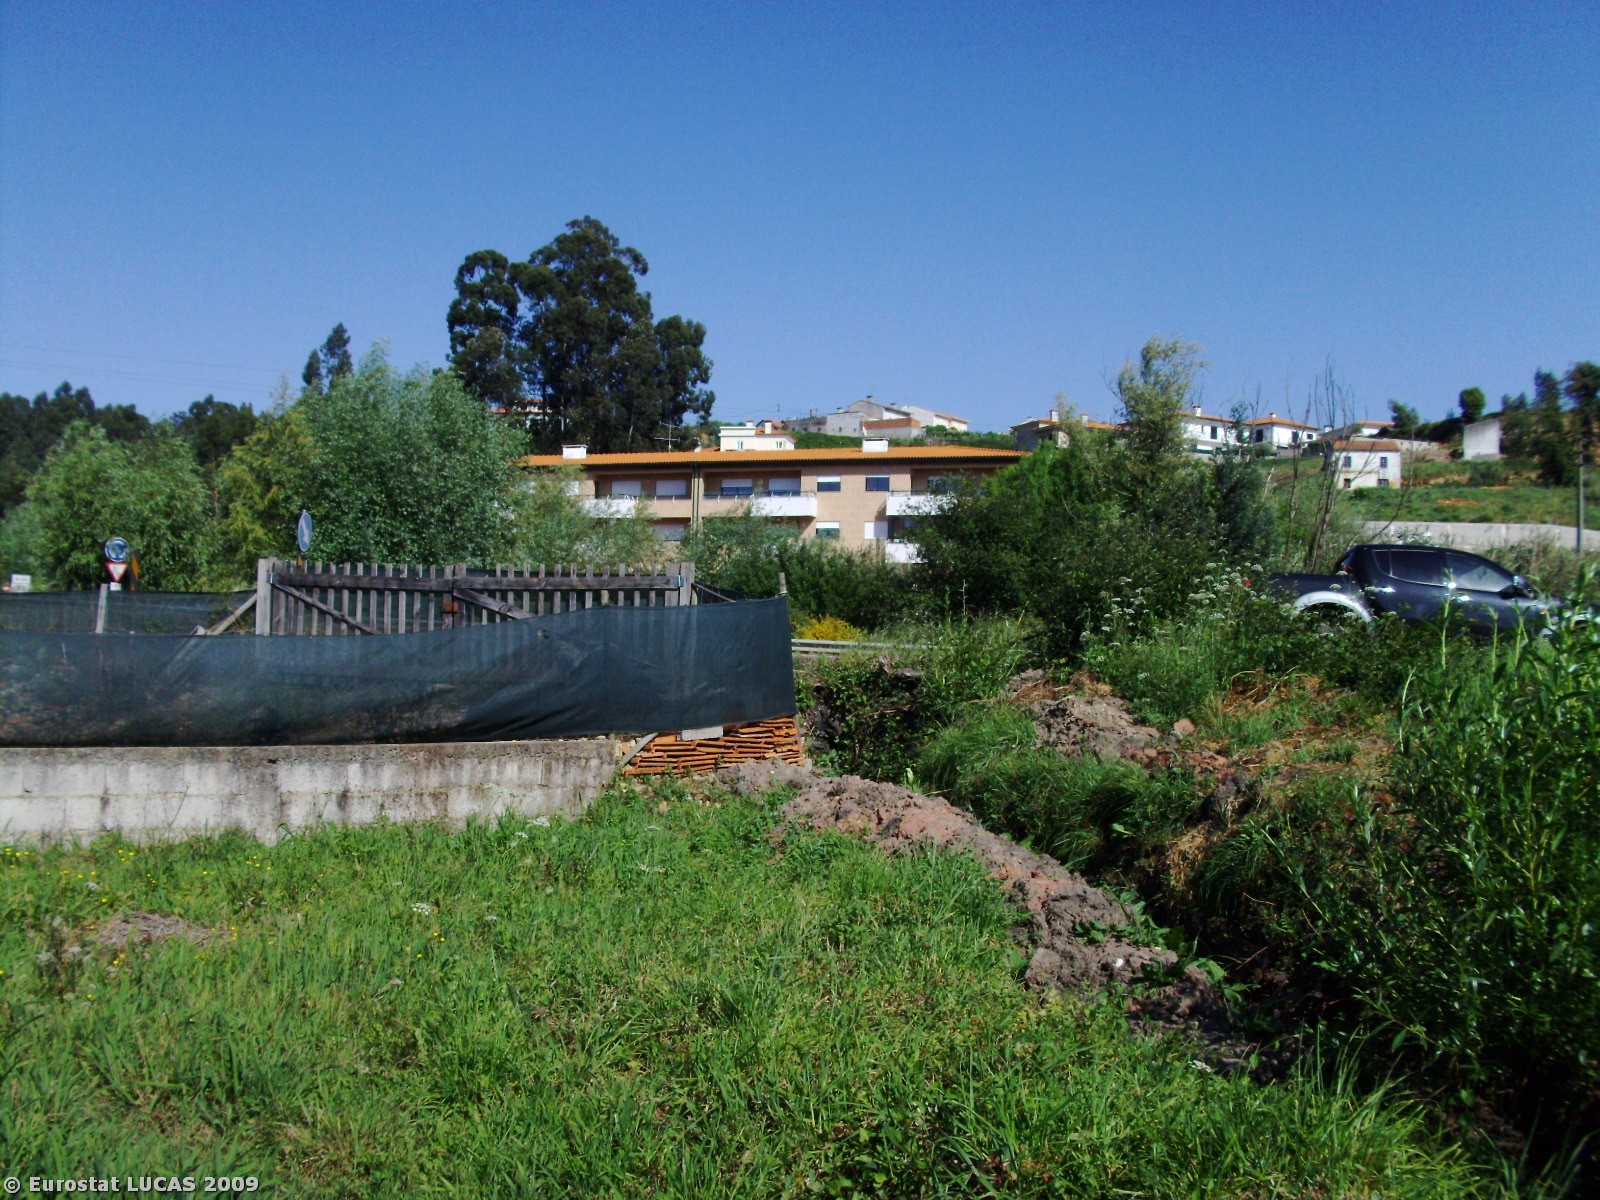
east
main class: Grassland
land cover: Spontaneously vegetated surfaces
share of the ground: > 75 %
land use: Fallow land
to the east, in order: Spontaneously vegetated surfaces; Artificial constructions; Dry pulses; Fences; Grass margins; Artificial constructions; Paved roads, cycling and walking lanes; Spontaneously vegetated surfaces; Rivers and streams; Artificial constructions in urban areas; Oats; Tracks; Broadleaved woodland
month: May
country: PT
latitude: 40.5746
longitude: -8.4355
